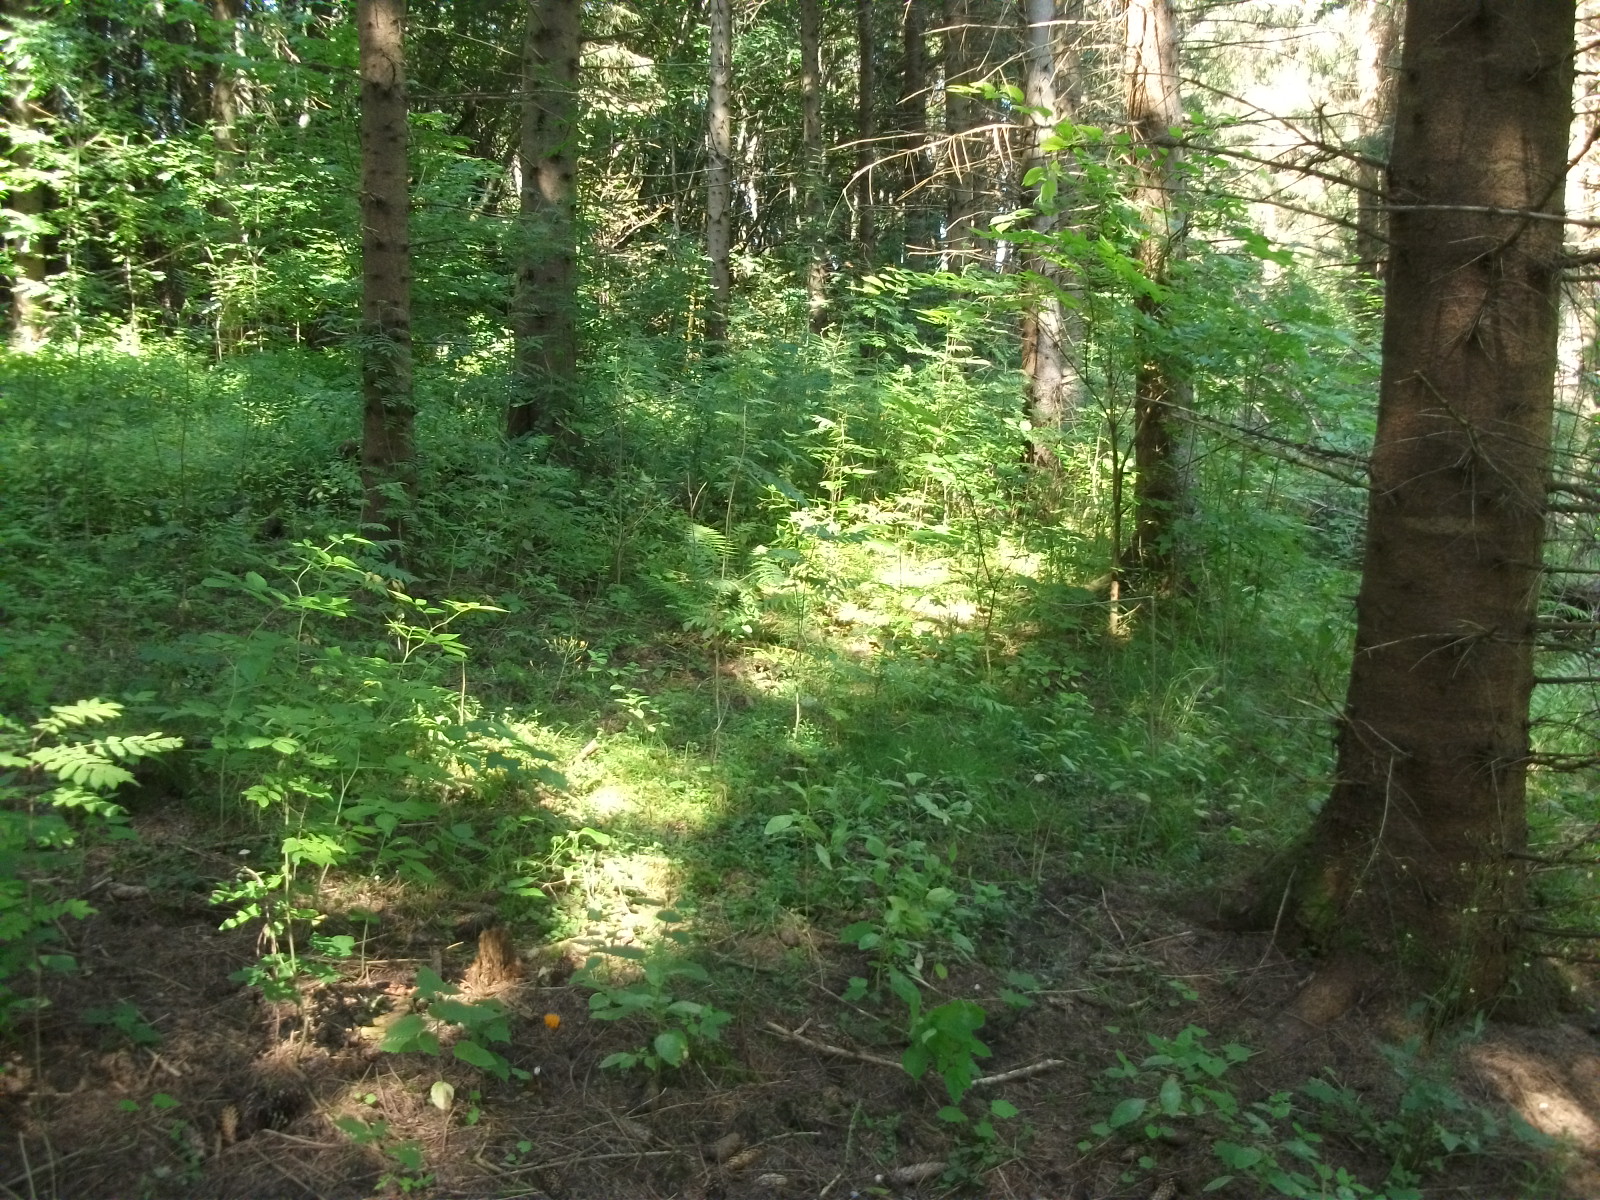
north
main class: Woodland
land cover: Spruce dominated coniferous woodland
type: hemiboreal forest and nemoral coniferous forest and mixed broadleaved-coniferous forest
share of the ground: > 75 %
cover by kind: coniferous forest trees 85 %, herbaceous plants 5 %, lichens and mosses 5 %, unconsolidated bare surface 5 %
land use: Forestry
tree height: > 5 m
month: August
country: LV
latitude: 56.8799
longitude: 25.7301
